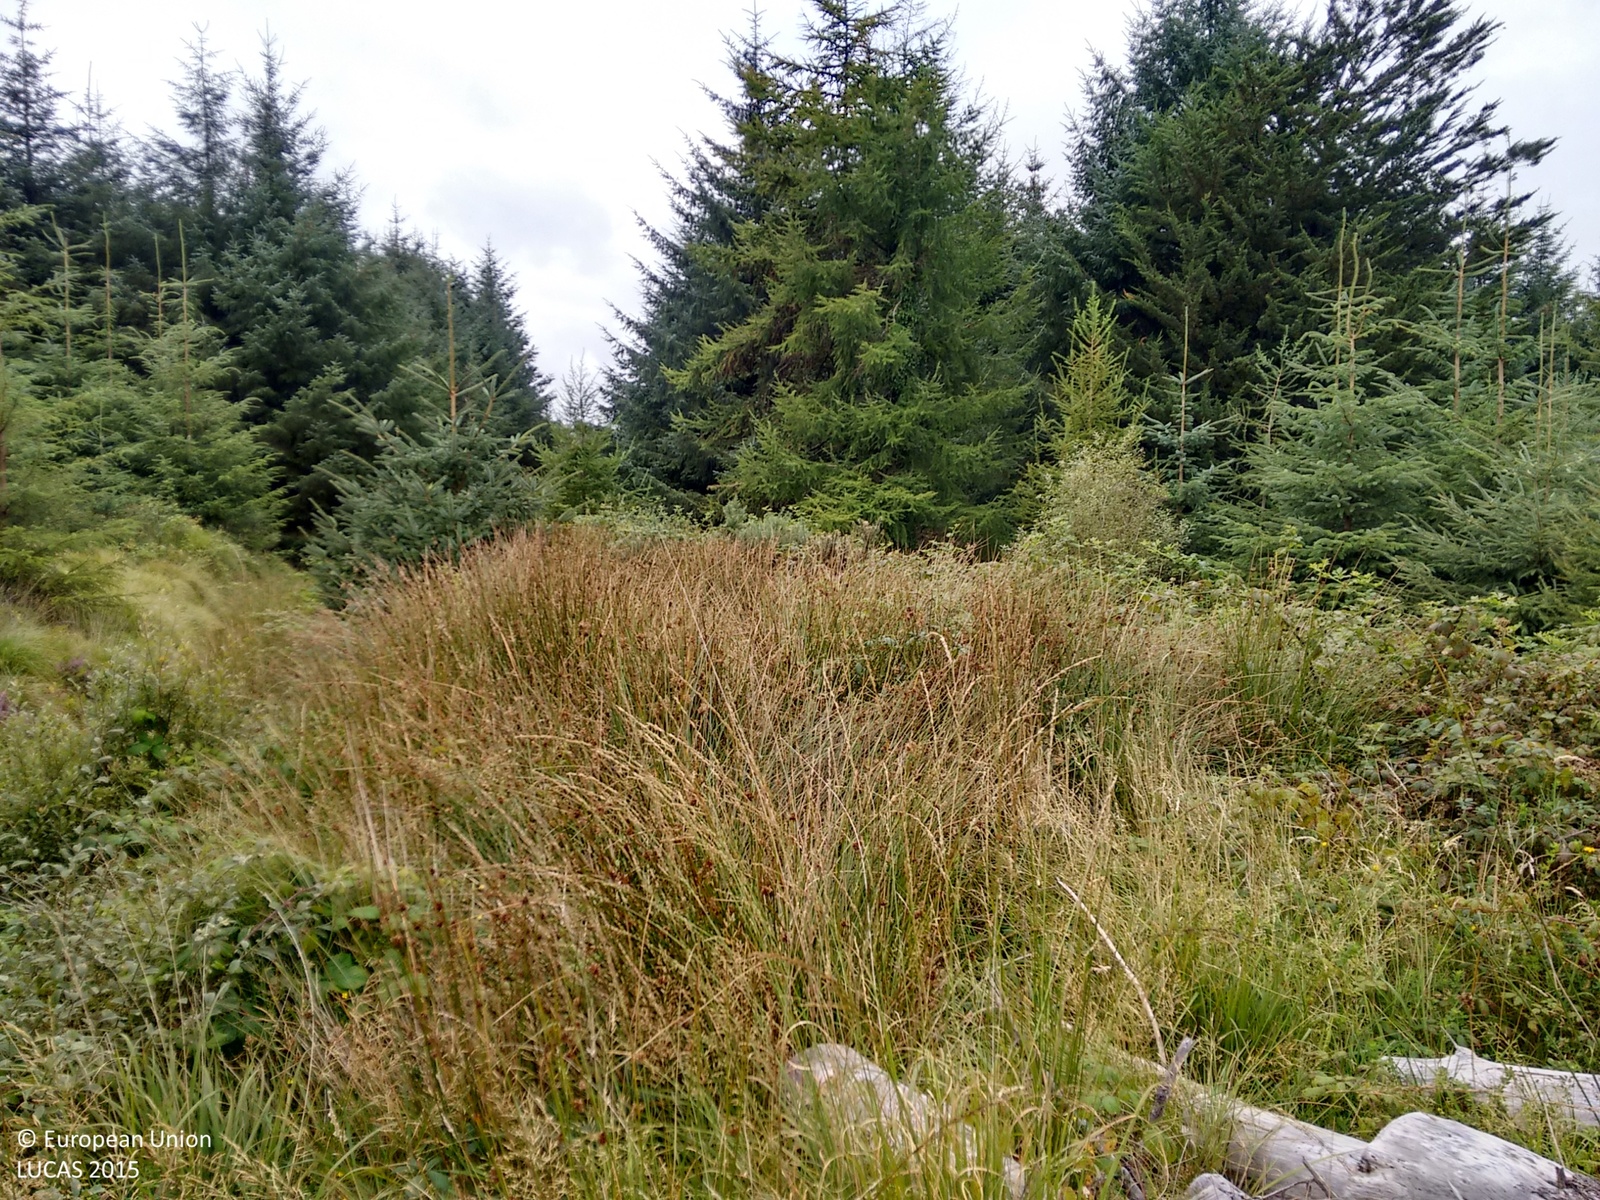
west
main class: Woodland
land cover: Spruce dominated coniferous woodland
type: exotic forest
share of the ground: > 75 %
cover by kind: coniferous forest trees 95 %, herbaceous plants 5 %
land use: Forestry
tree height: > 5 m
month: September
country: IE
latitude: 52.7993
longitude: -9.1286
